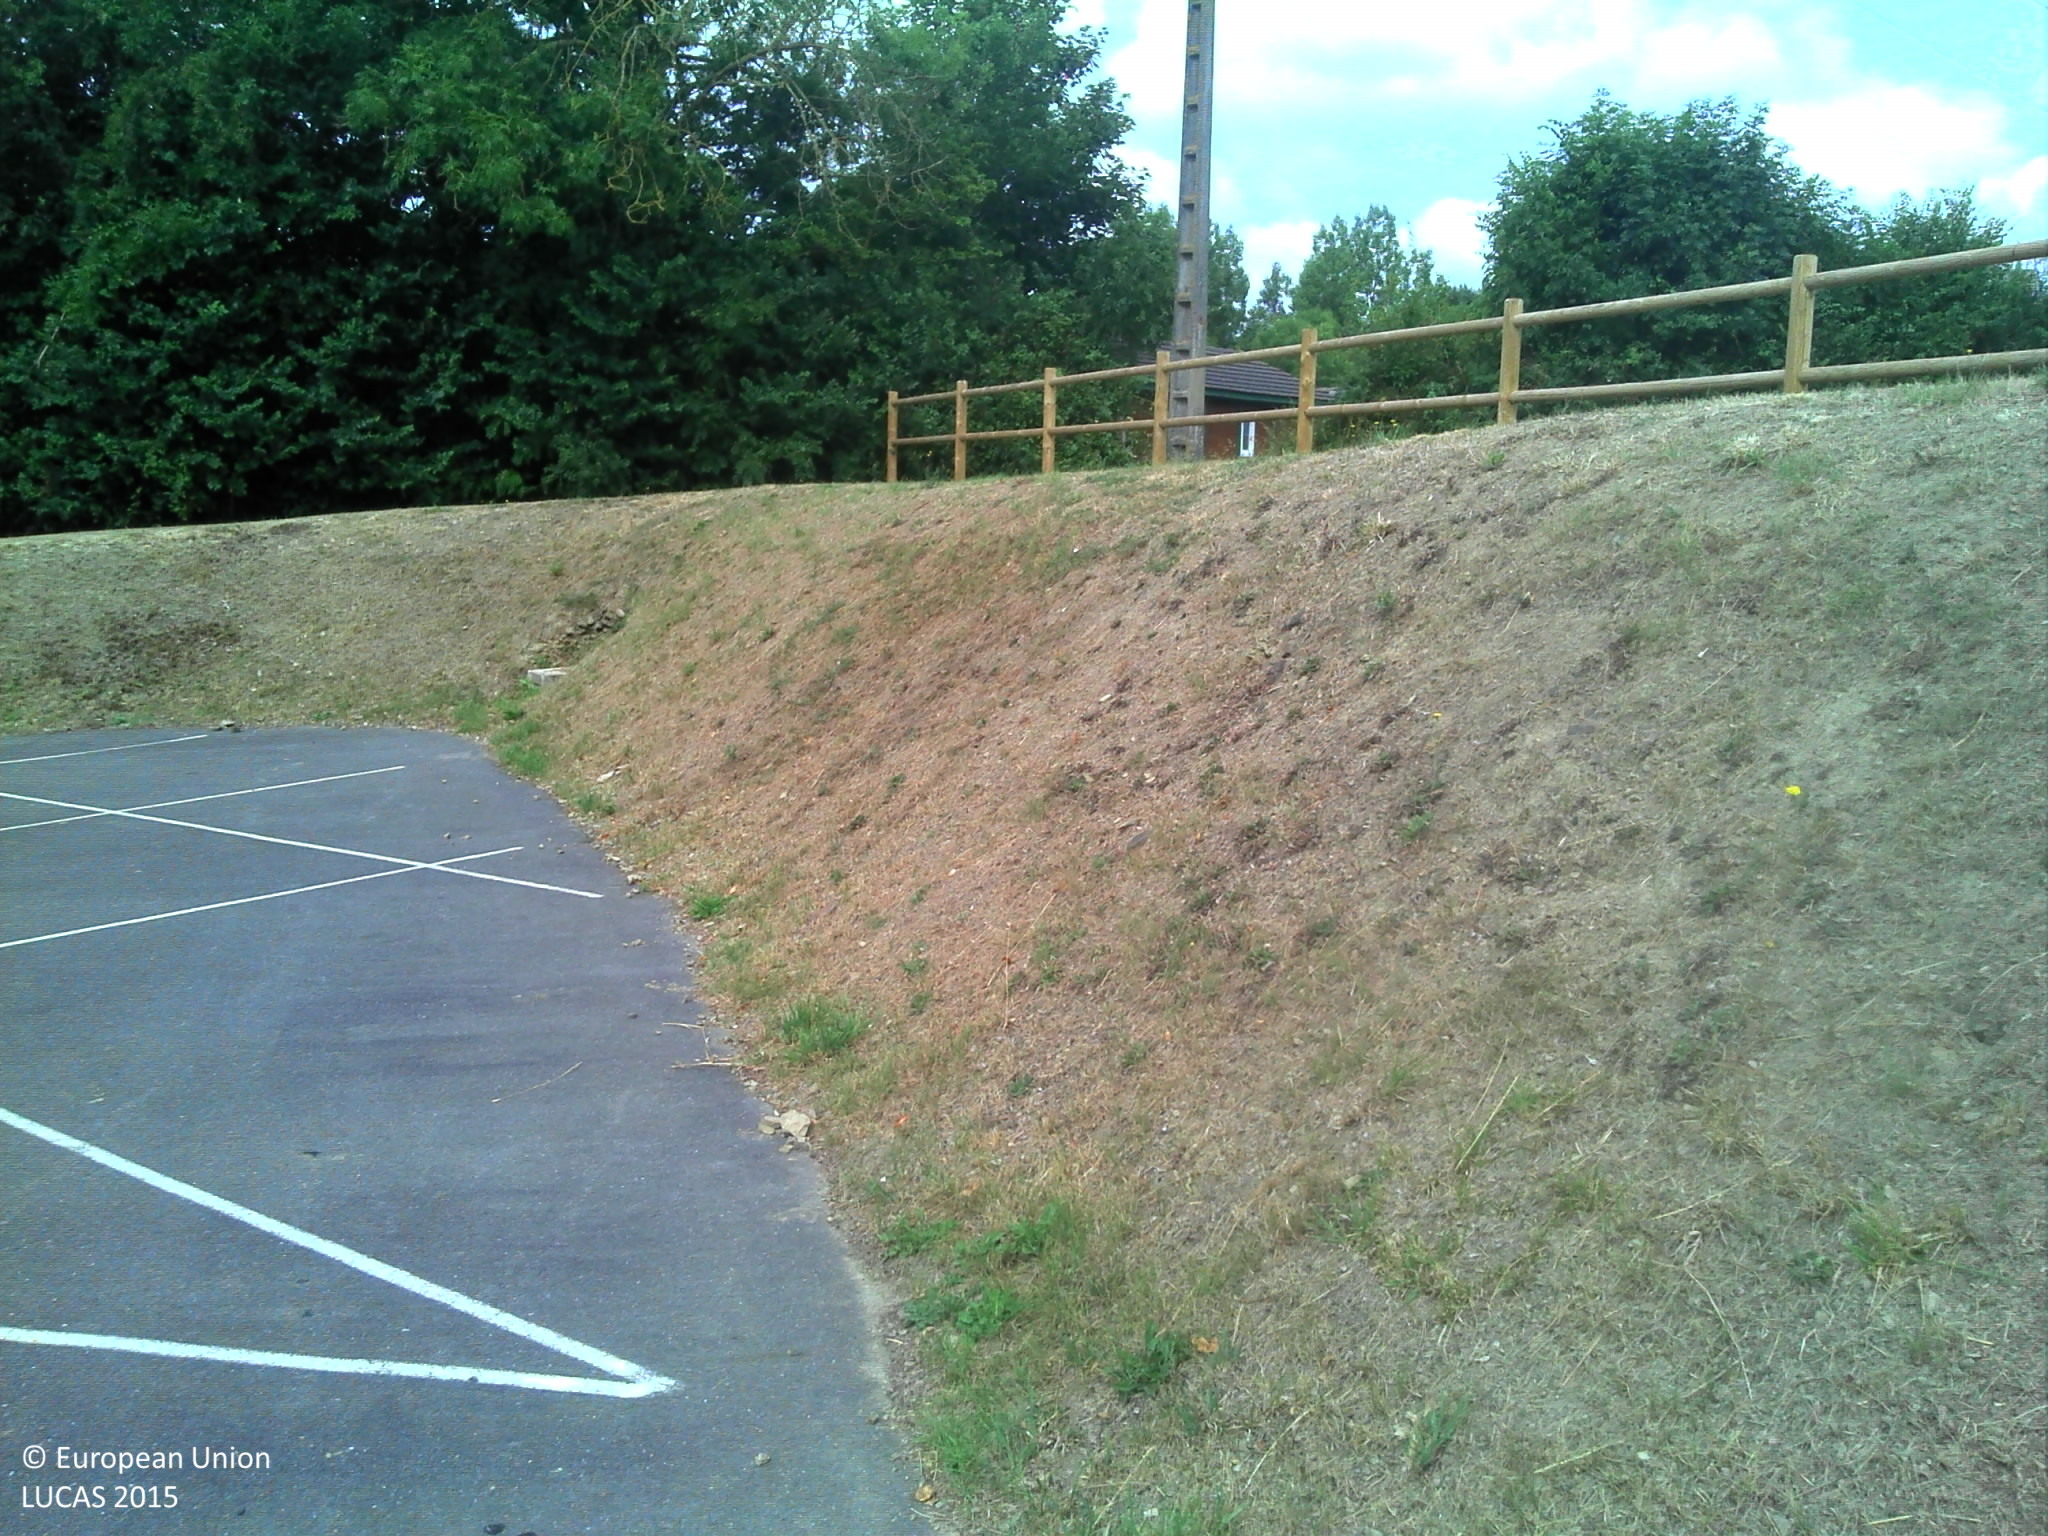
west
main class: Grassland
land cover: Grassland without tree/shrub cover
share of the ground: > 75 %
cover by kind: herbaceous plants 100 %
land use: Semi-natural and natural areas not in use
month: July
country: FR
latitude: 48.7981
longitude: -1.5247
